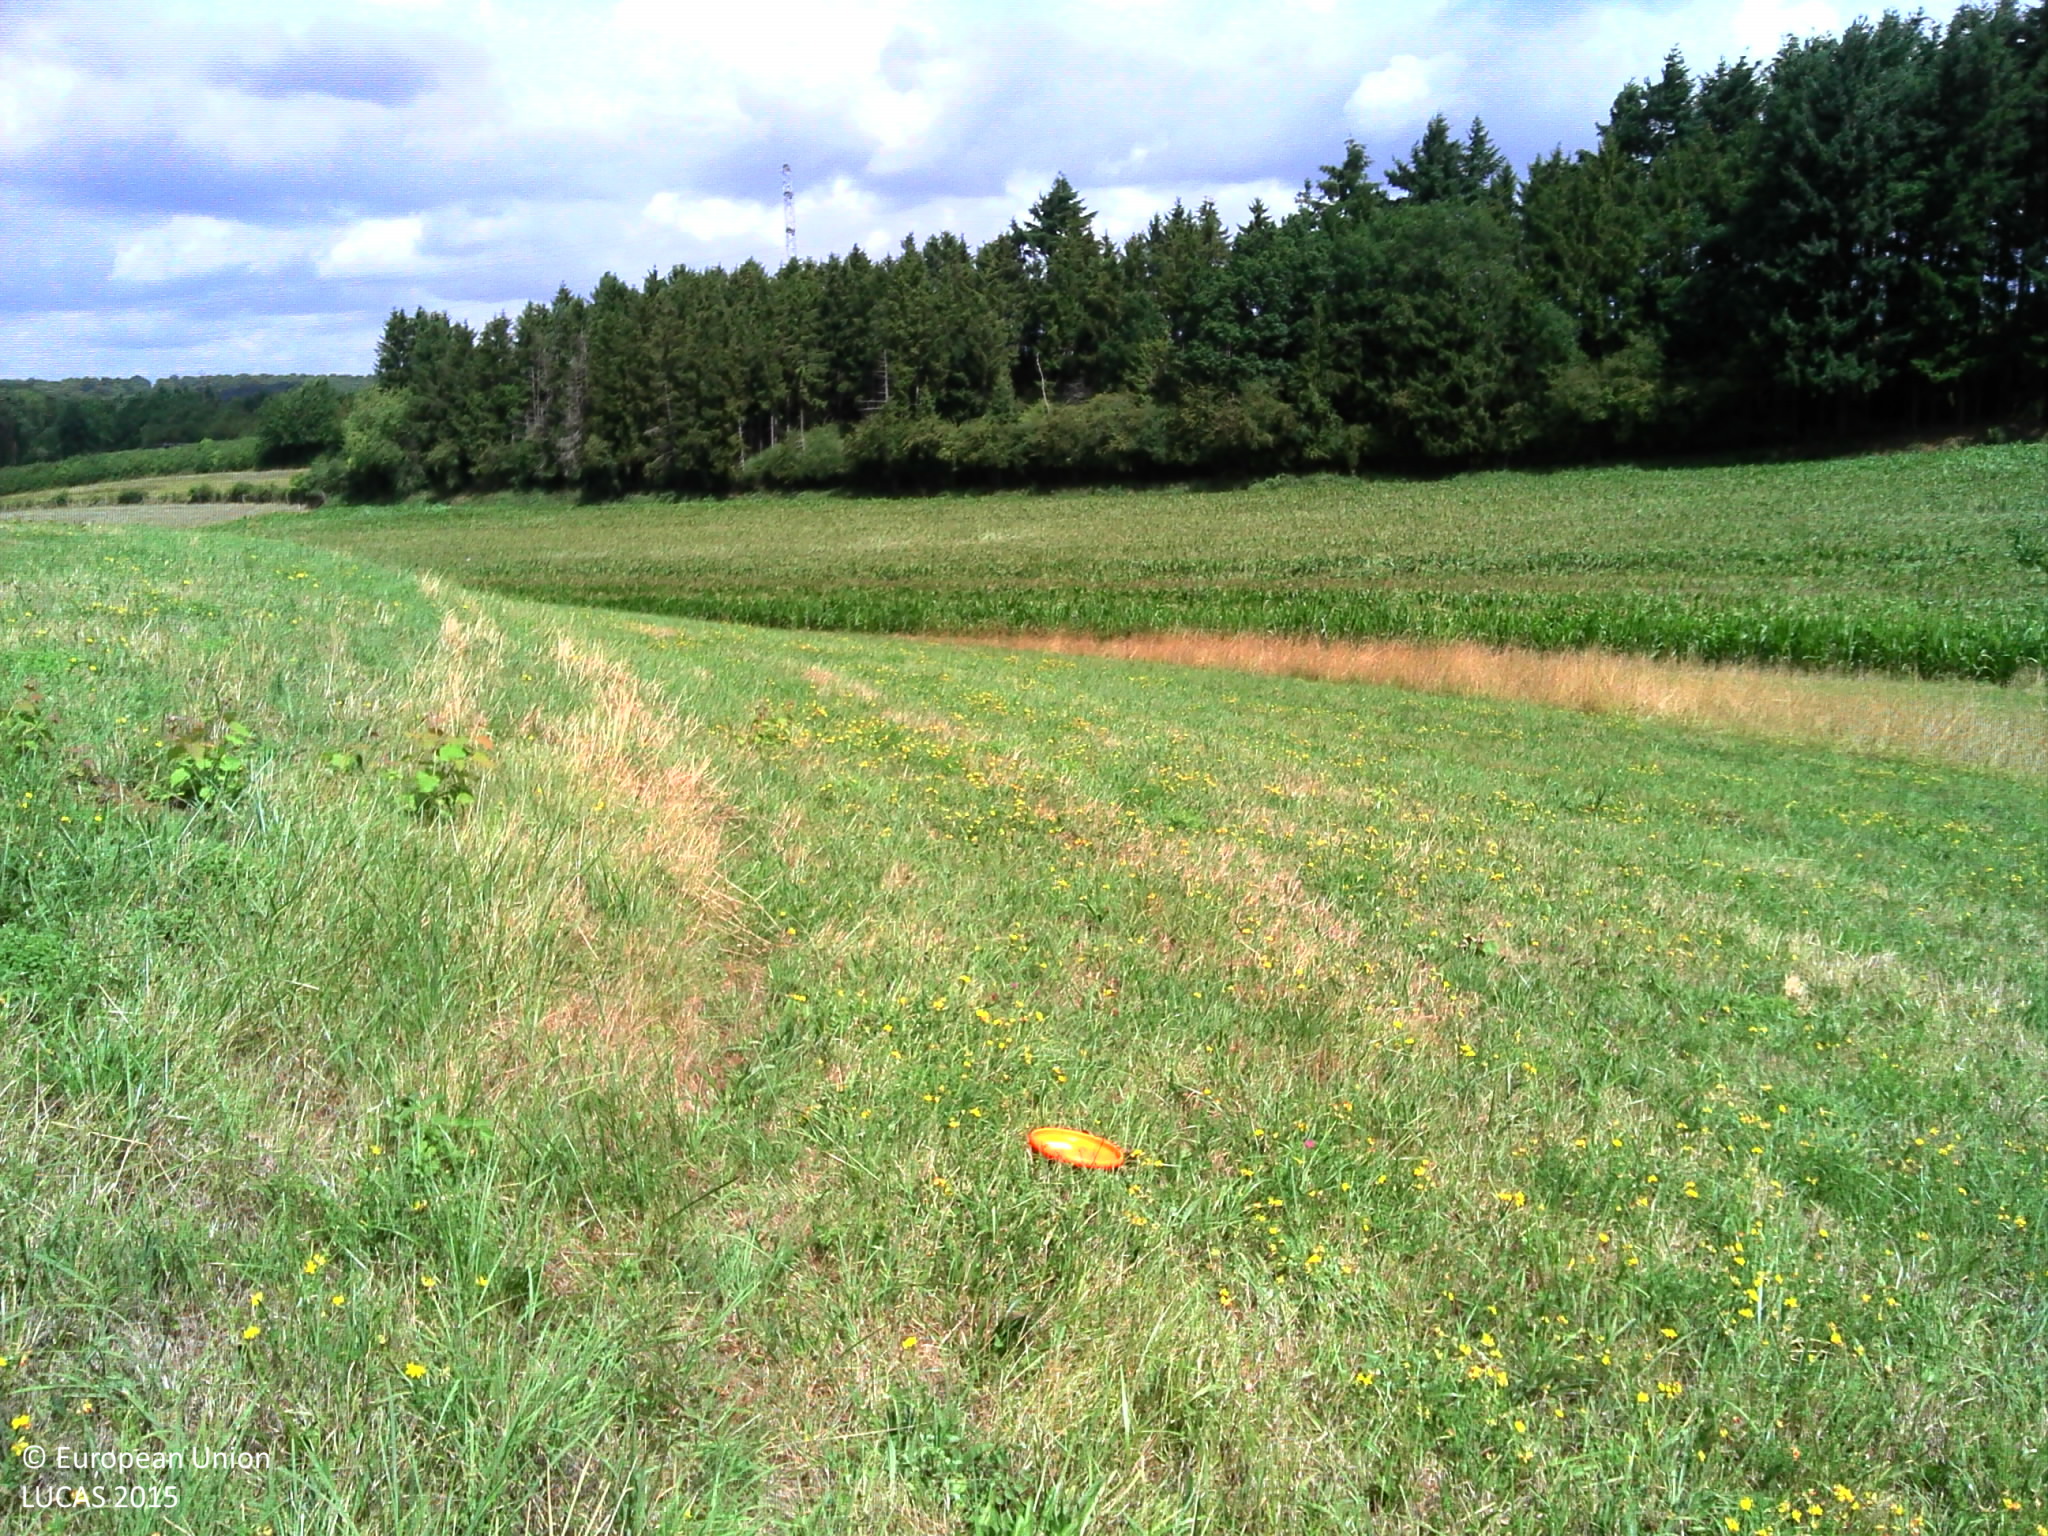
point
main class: Grassland
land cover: Grassland without tree/shrub cover
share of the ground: > 75 %
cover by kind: herbaceous plants 100 %
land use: Agriculture (excluding fallow land and kitchen gardens)
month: July
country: BE
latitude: 49.5650
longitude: 5.7542
